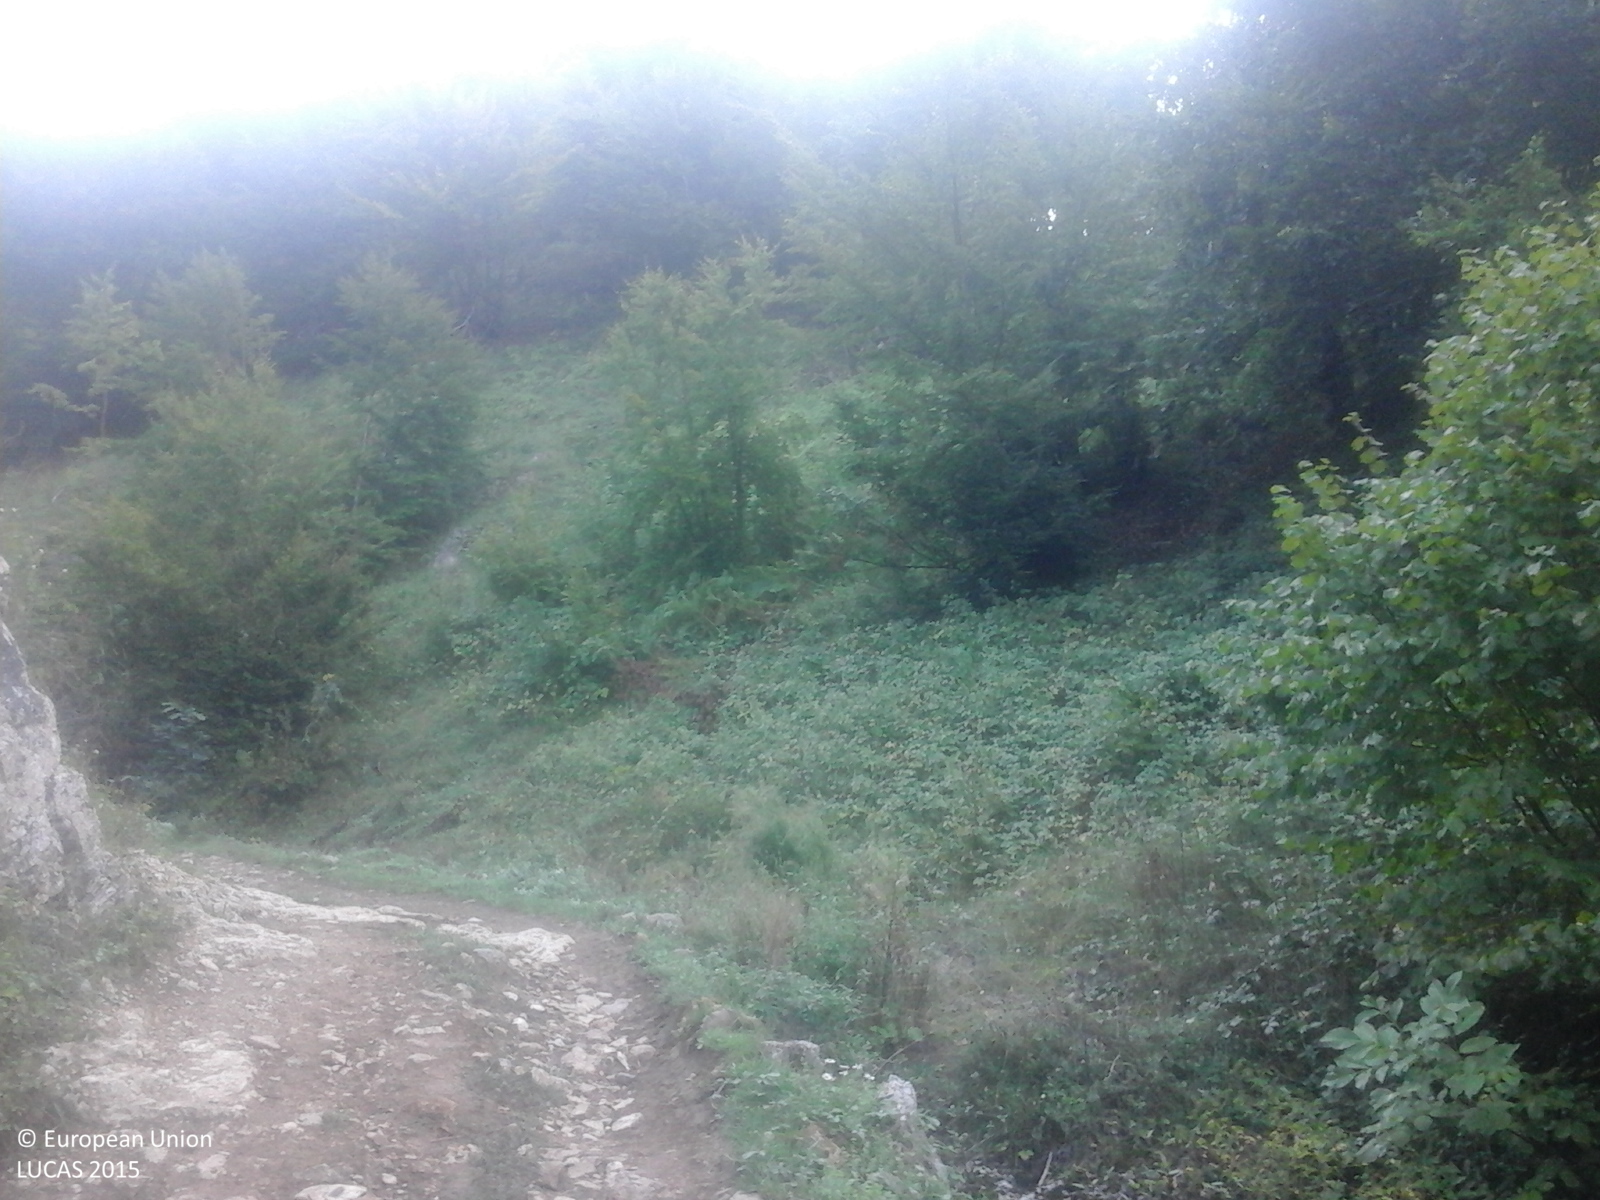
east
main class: Grassland
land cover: Grassland with sparse tree/shrub cover
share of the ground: > 75 %
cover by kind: herbaceous plants 85 %, shrubs 10 %, broadleaved forest trees 5 %
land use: Fallow land
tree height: > 5 m
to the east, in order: Grassland with sparse tree/shrub cover; Rocks and stones; Tracks; Grass margins; Ditches and canals; Grassland with sparse tree/shrub cover; Broadleaved woodland; Grassland without tree/shrub cover
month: September
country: RO
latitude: 45.8397
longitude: 22.4456
